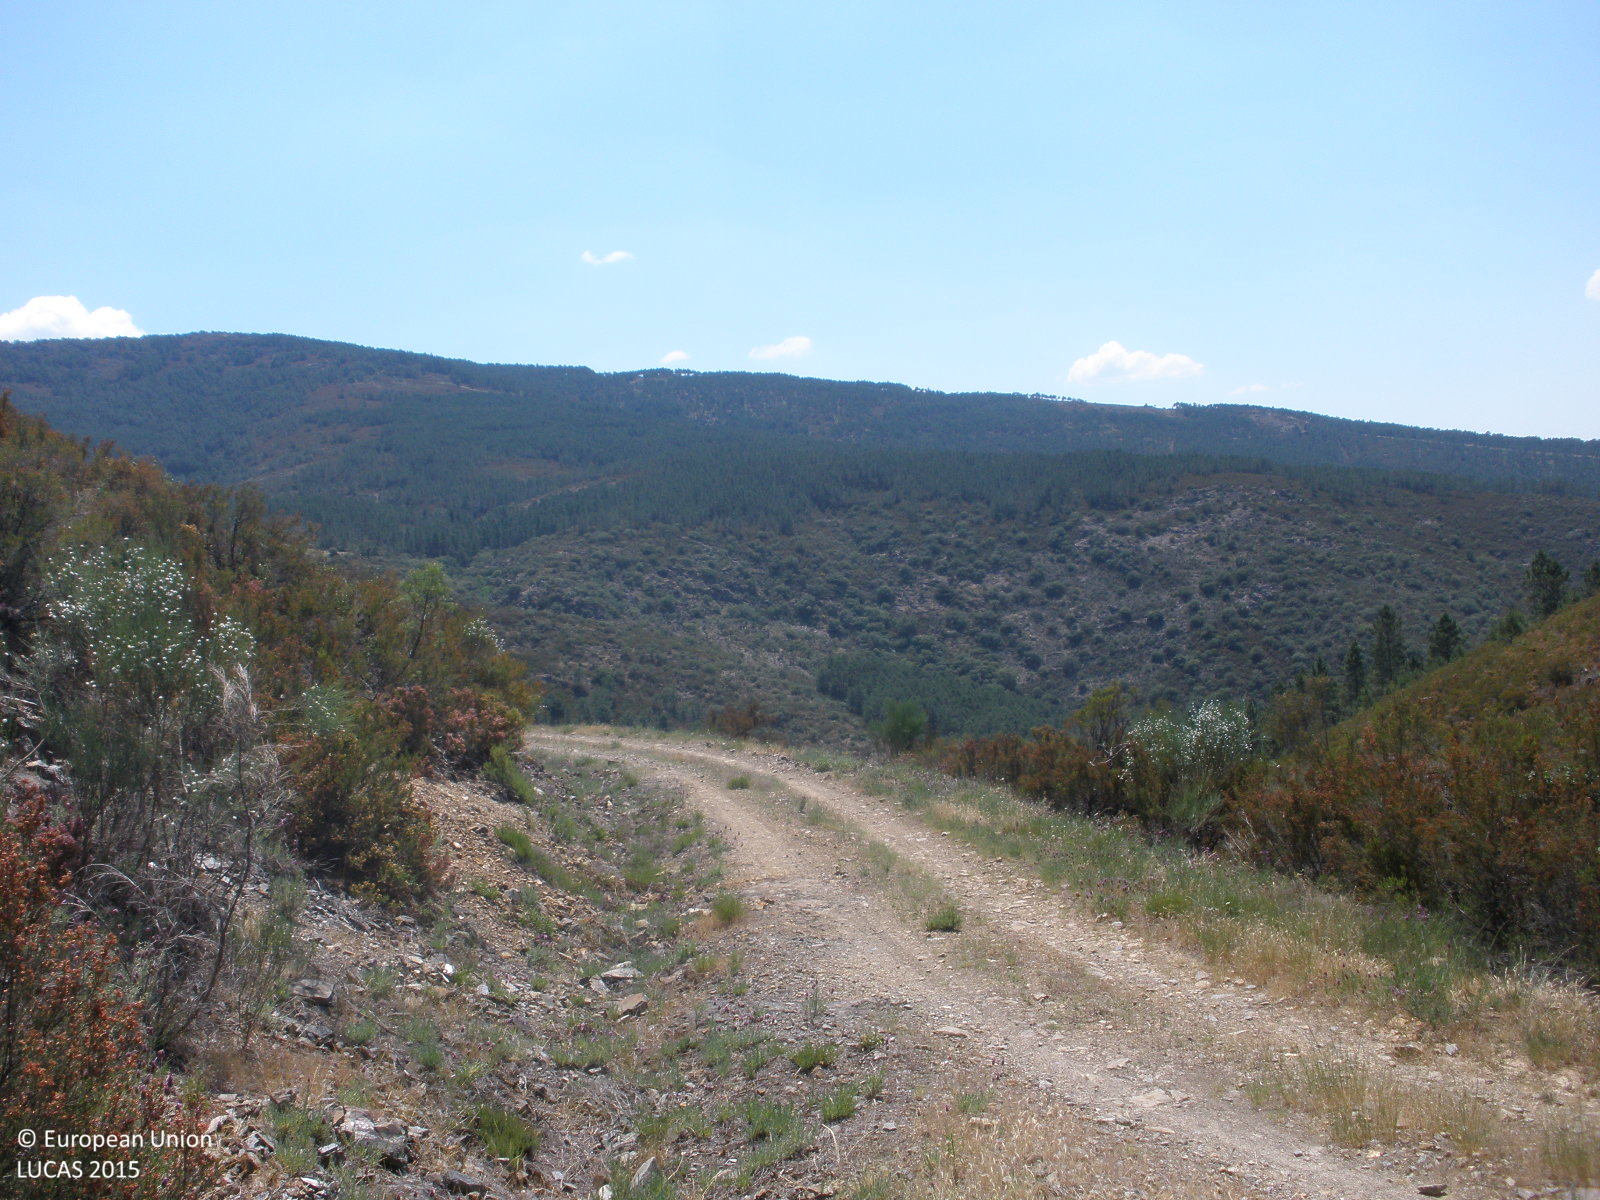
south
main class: Shrubland
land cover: Shrubland with sparse tree cover
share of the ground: > 75 %
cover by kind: shrubs 95 %, coniferous forest trees 5 %
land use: Forestry
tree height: < 5 m
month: June
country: ES
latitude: 40.5059
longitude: -6.2373
